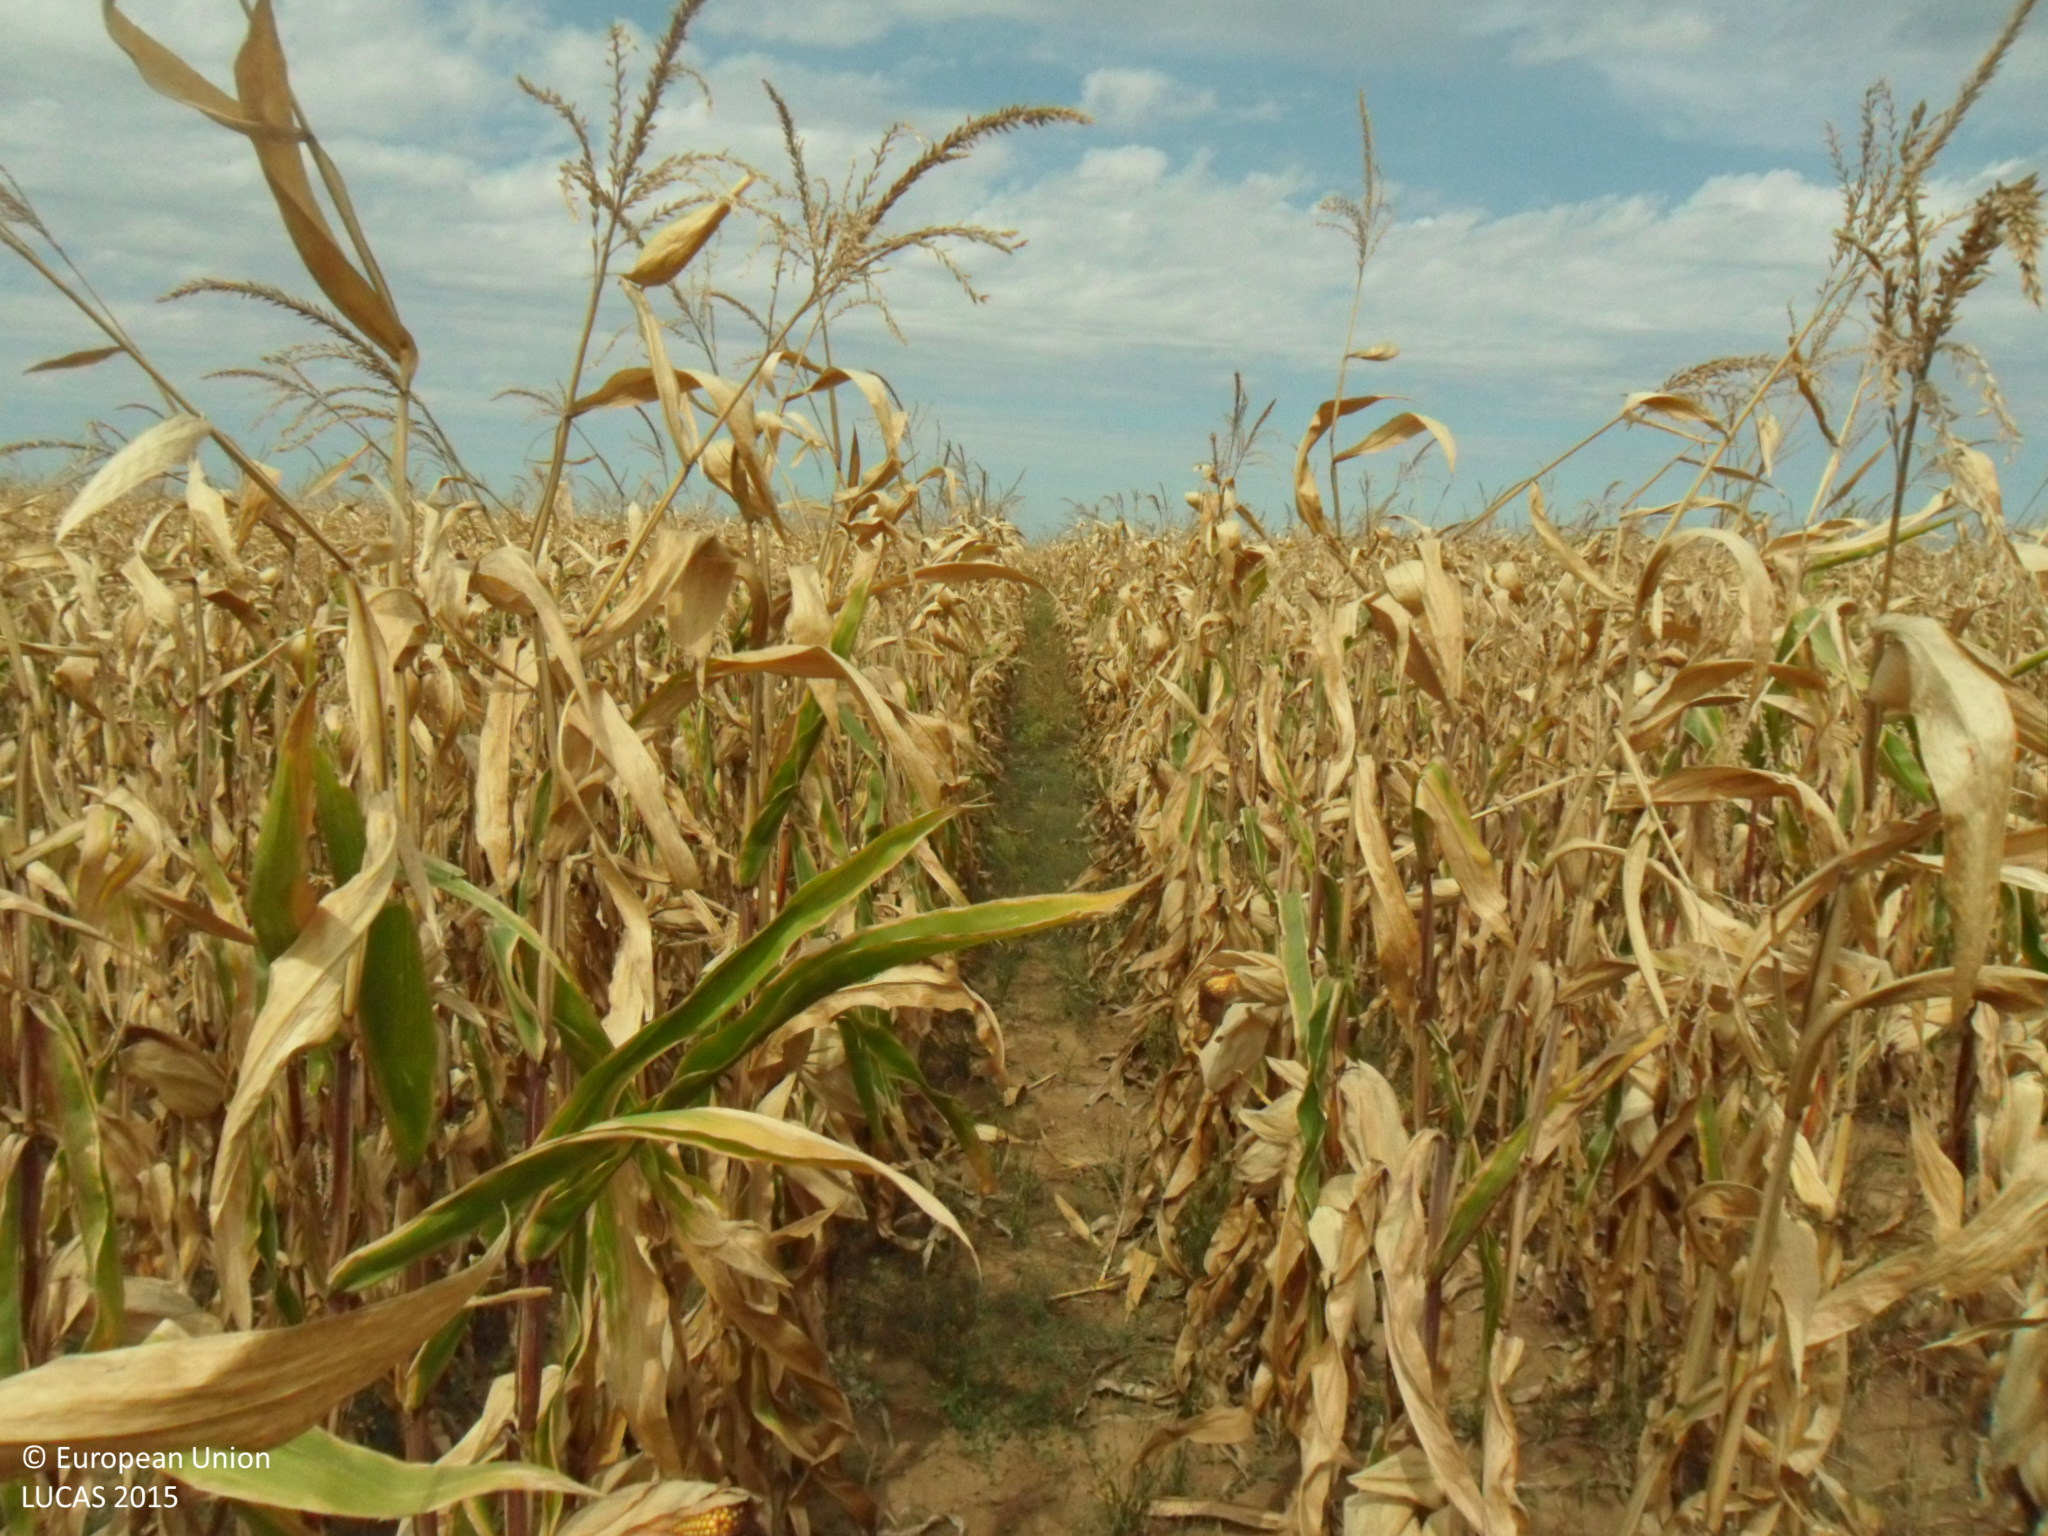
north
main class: Cropland
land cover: Maize
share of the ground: > 75 %
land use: Agriculture (excluding fallow land and kitchen gardens)
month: September
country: BG
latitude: 43.5255
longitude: 26.3211
